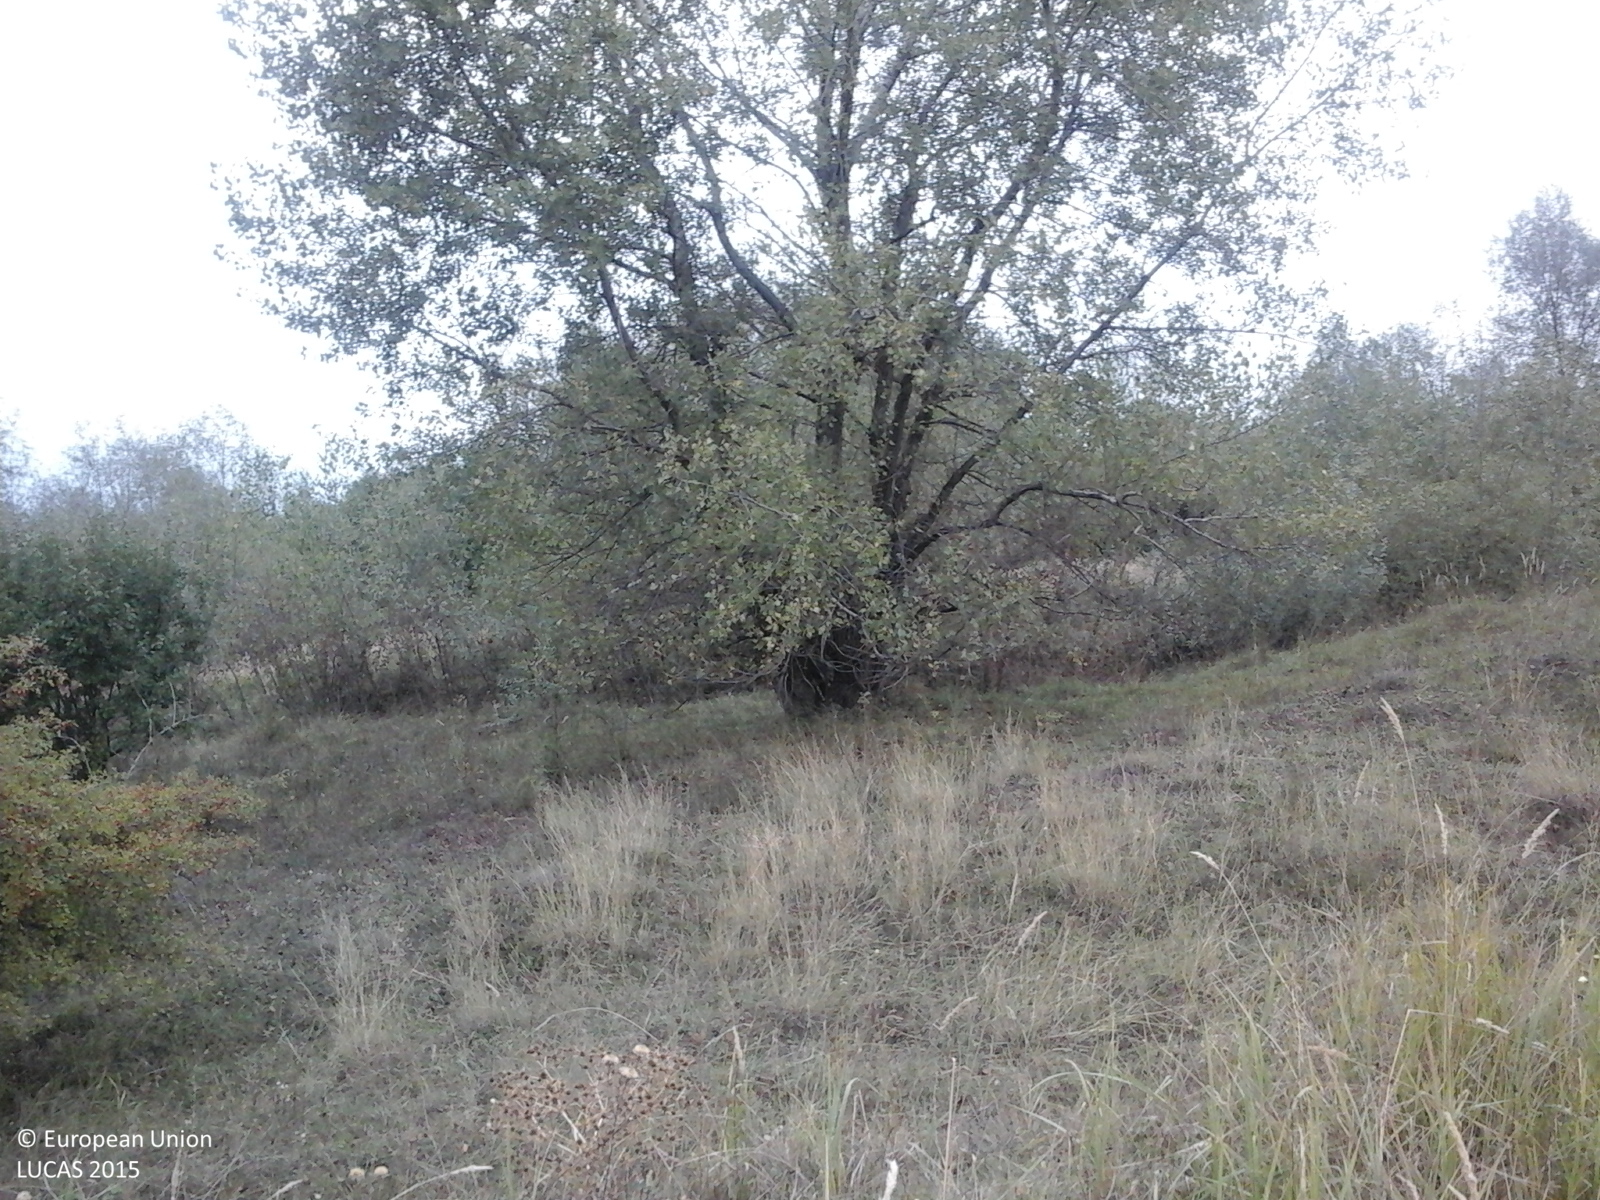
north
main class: Grassland
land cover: Spontaneously vegetated surfaces
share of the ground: > 75 %
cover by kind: herbaceous plants 100 %
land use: Fallow land
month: September
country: RO
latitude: 45.8466
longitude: 23.2844
